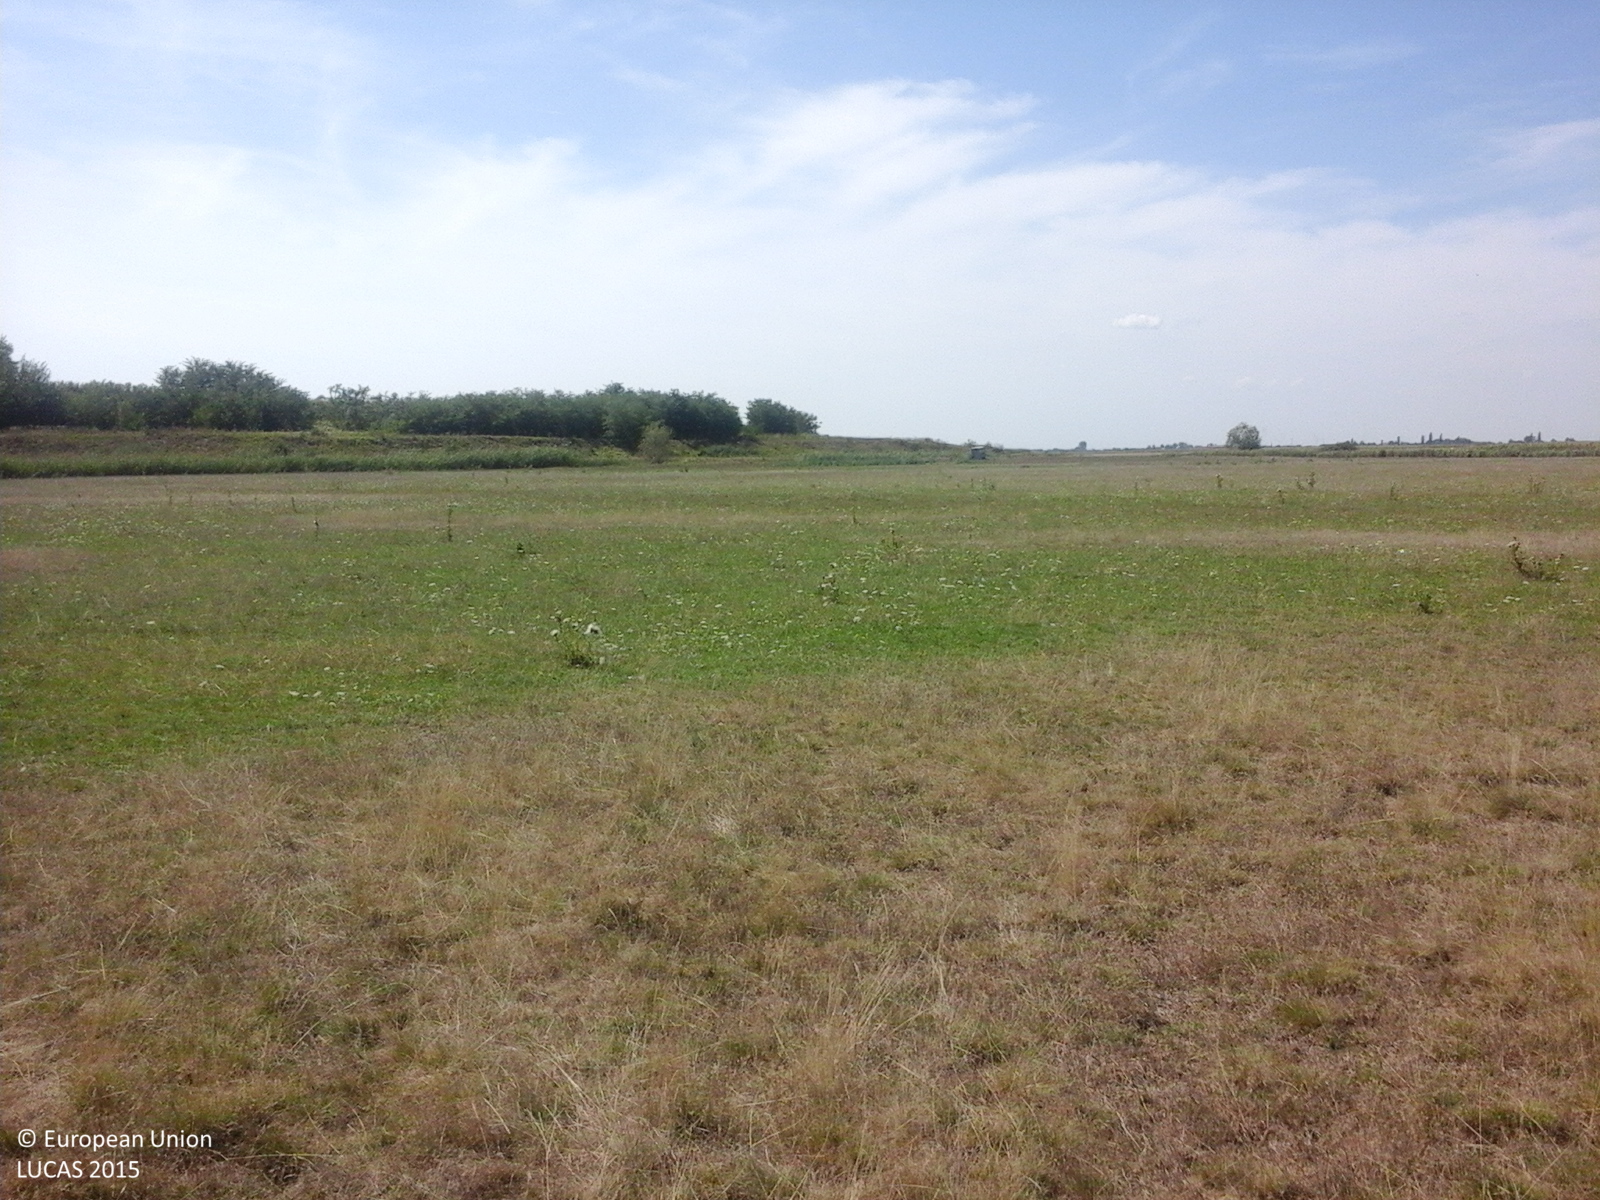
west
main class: Grassland
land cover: Grassland without tree/shrub cover
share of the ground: > 75 %
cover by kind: herbaceous plants 100 %
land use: Agriculture (excluding fallow land and kitchen gardens)
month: August
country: RO
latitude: 45.6949
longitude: 21.1376
